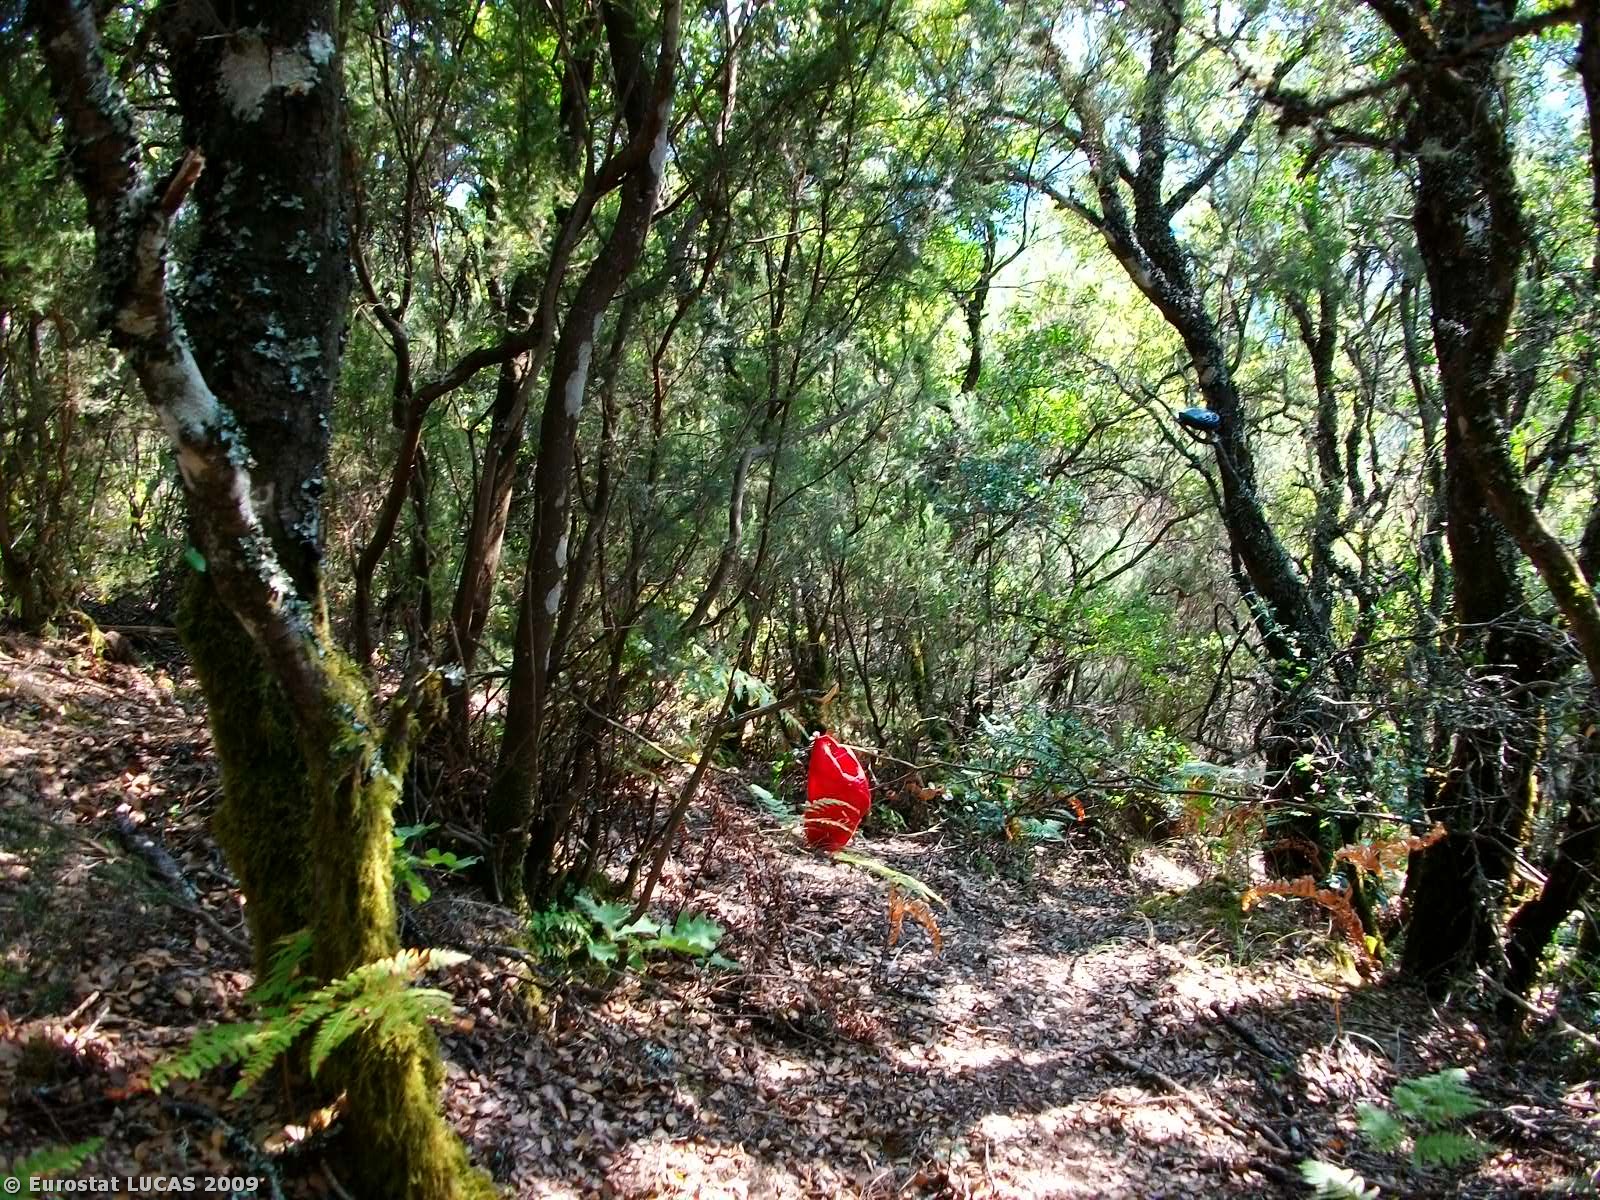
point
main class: Woodland
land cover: Mixed woodland
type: mesophytic deciduous forest
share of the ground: > 75 %
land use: Forestry
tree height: > 5 m
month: August
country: GR
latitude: 39.6501
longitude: 20.4766
